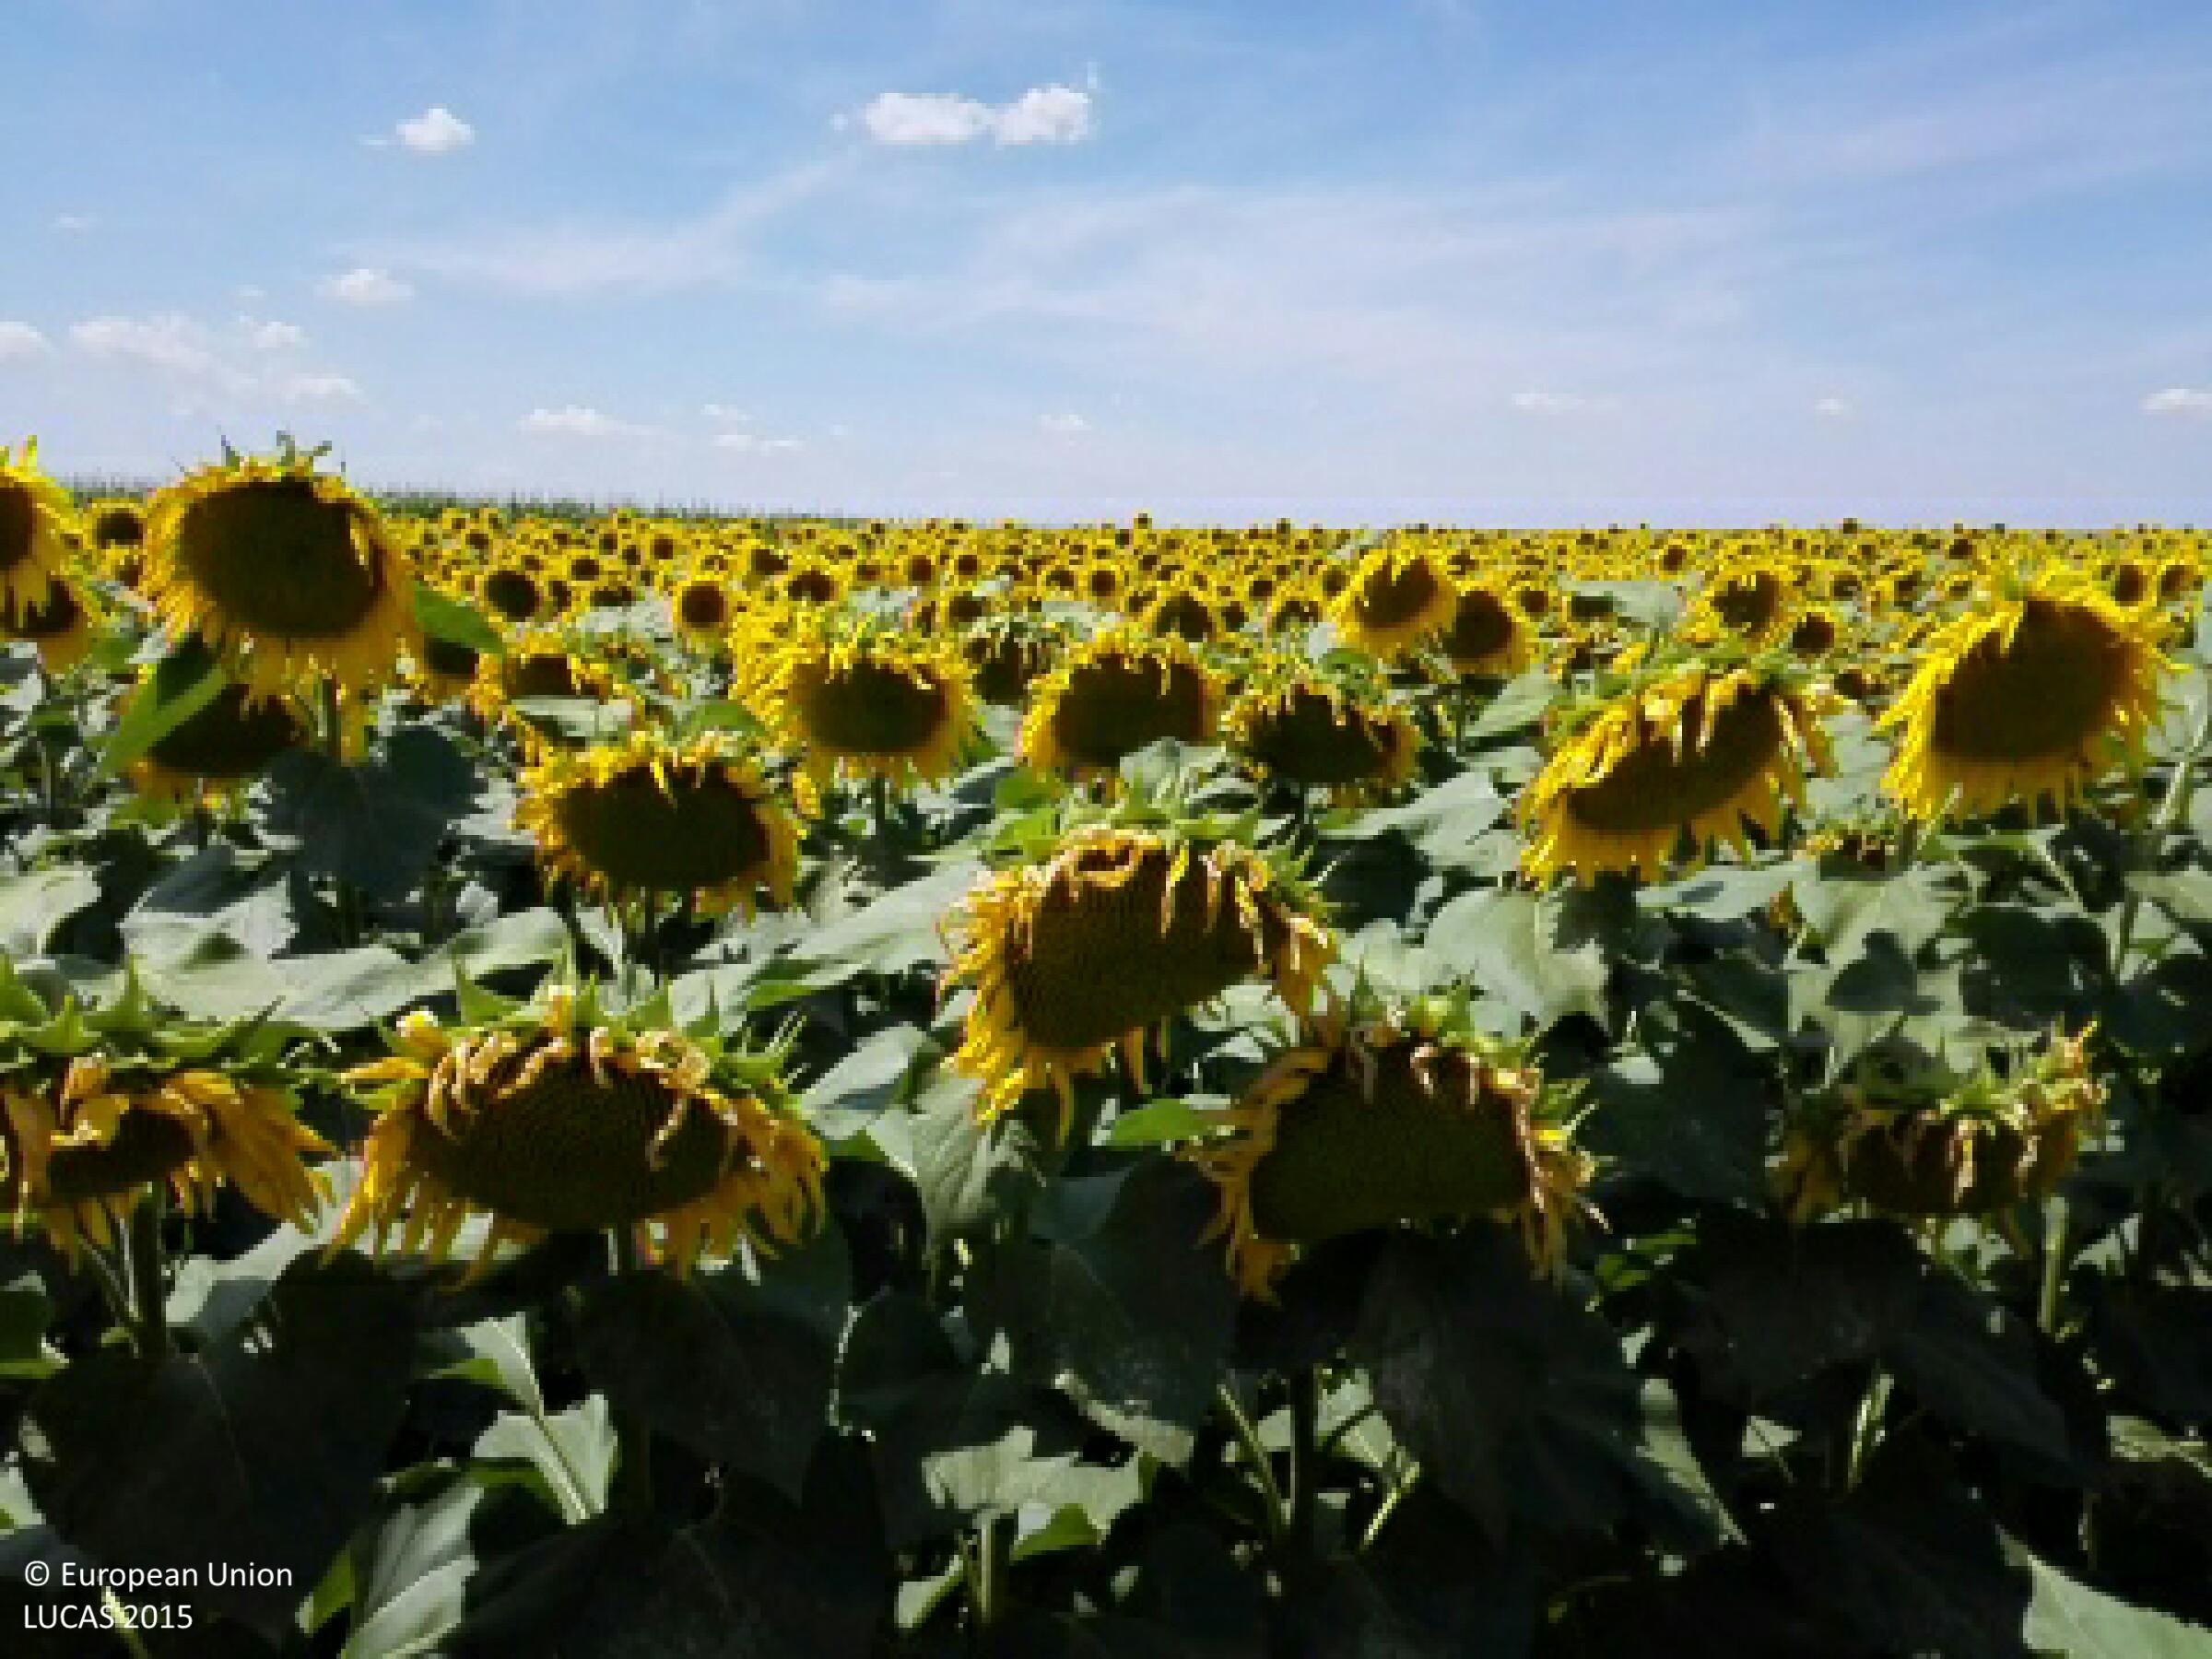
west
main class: Cropland
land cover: Sunflower
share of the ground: > 75 %
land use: Agriculture (excluding fallow land and kitchen gardens)
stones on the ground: < 10 %
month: July
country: HU
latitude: 47.4203
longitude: 21.3204
